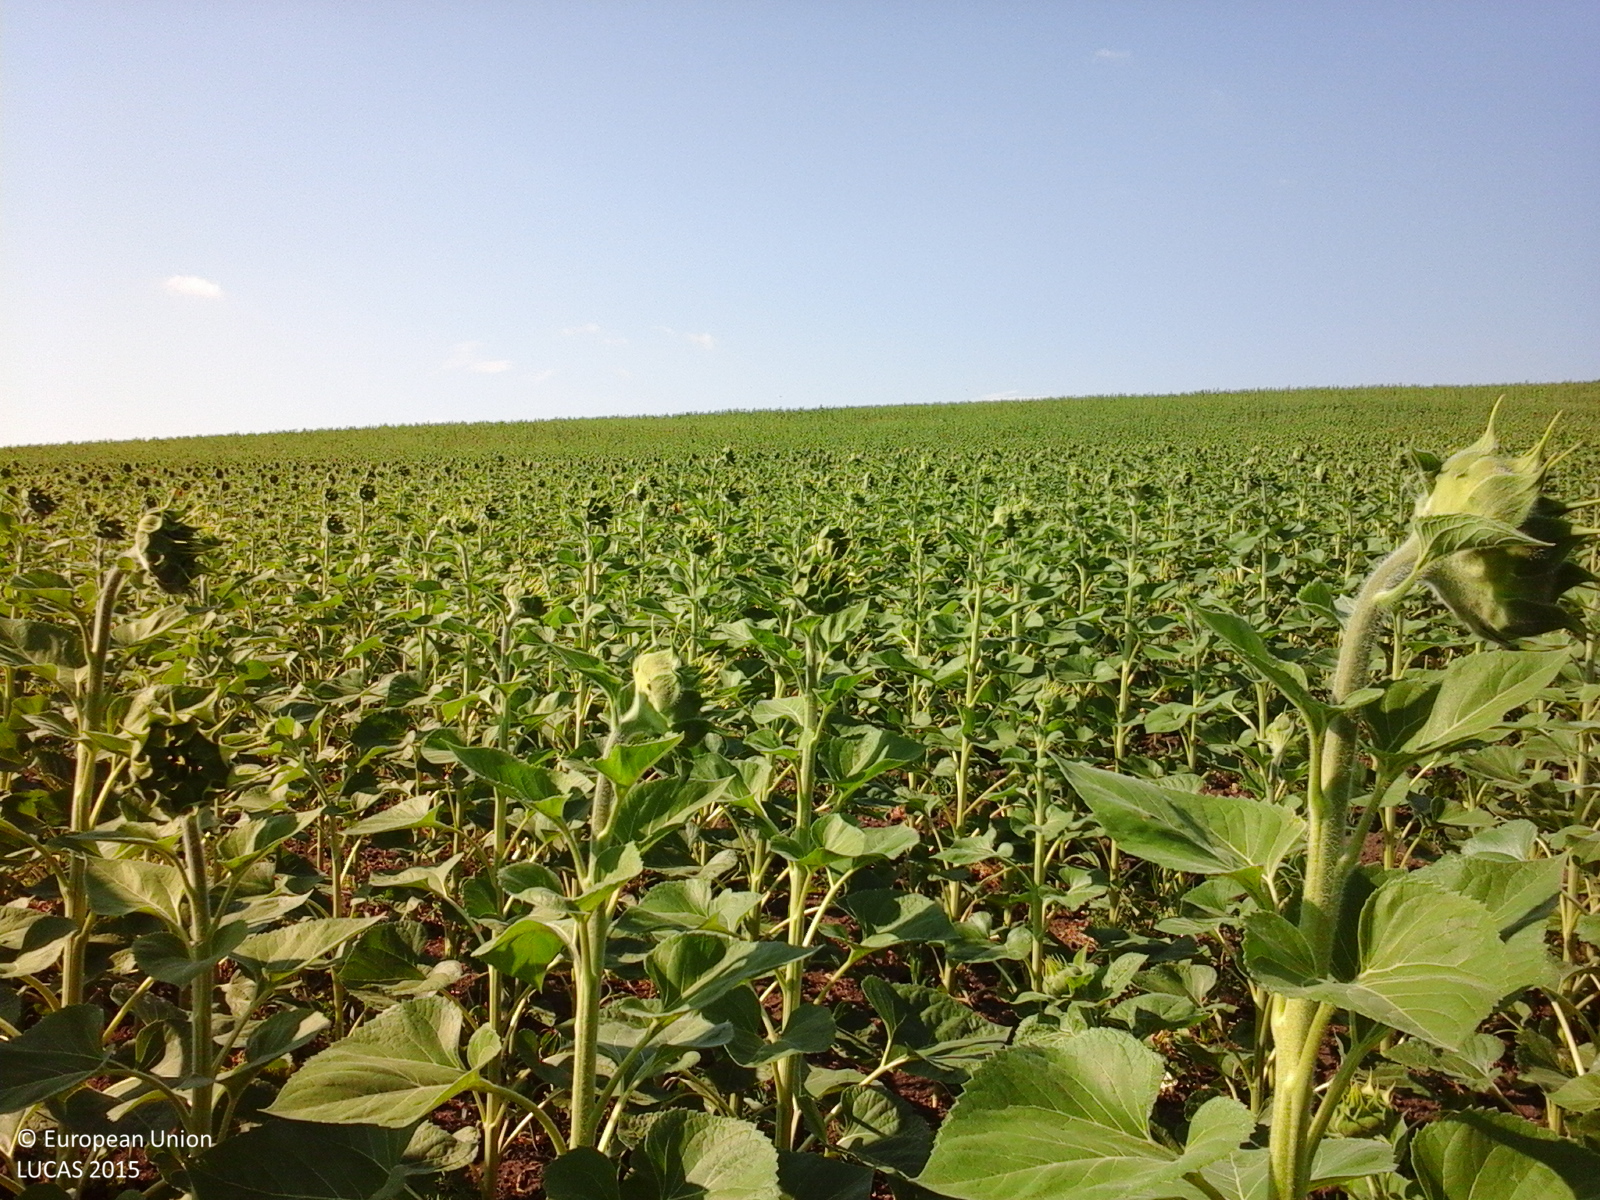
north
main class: Cropland
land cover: Sunflower
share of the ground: 50 - 75 %
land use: Agriculture (excluding fallow land and kitchen gardens)
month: June
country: RO
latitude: 46.8837
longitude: 28.0435
